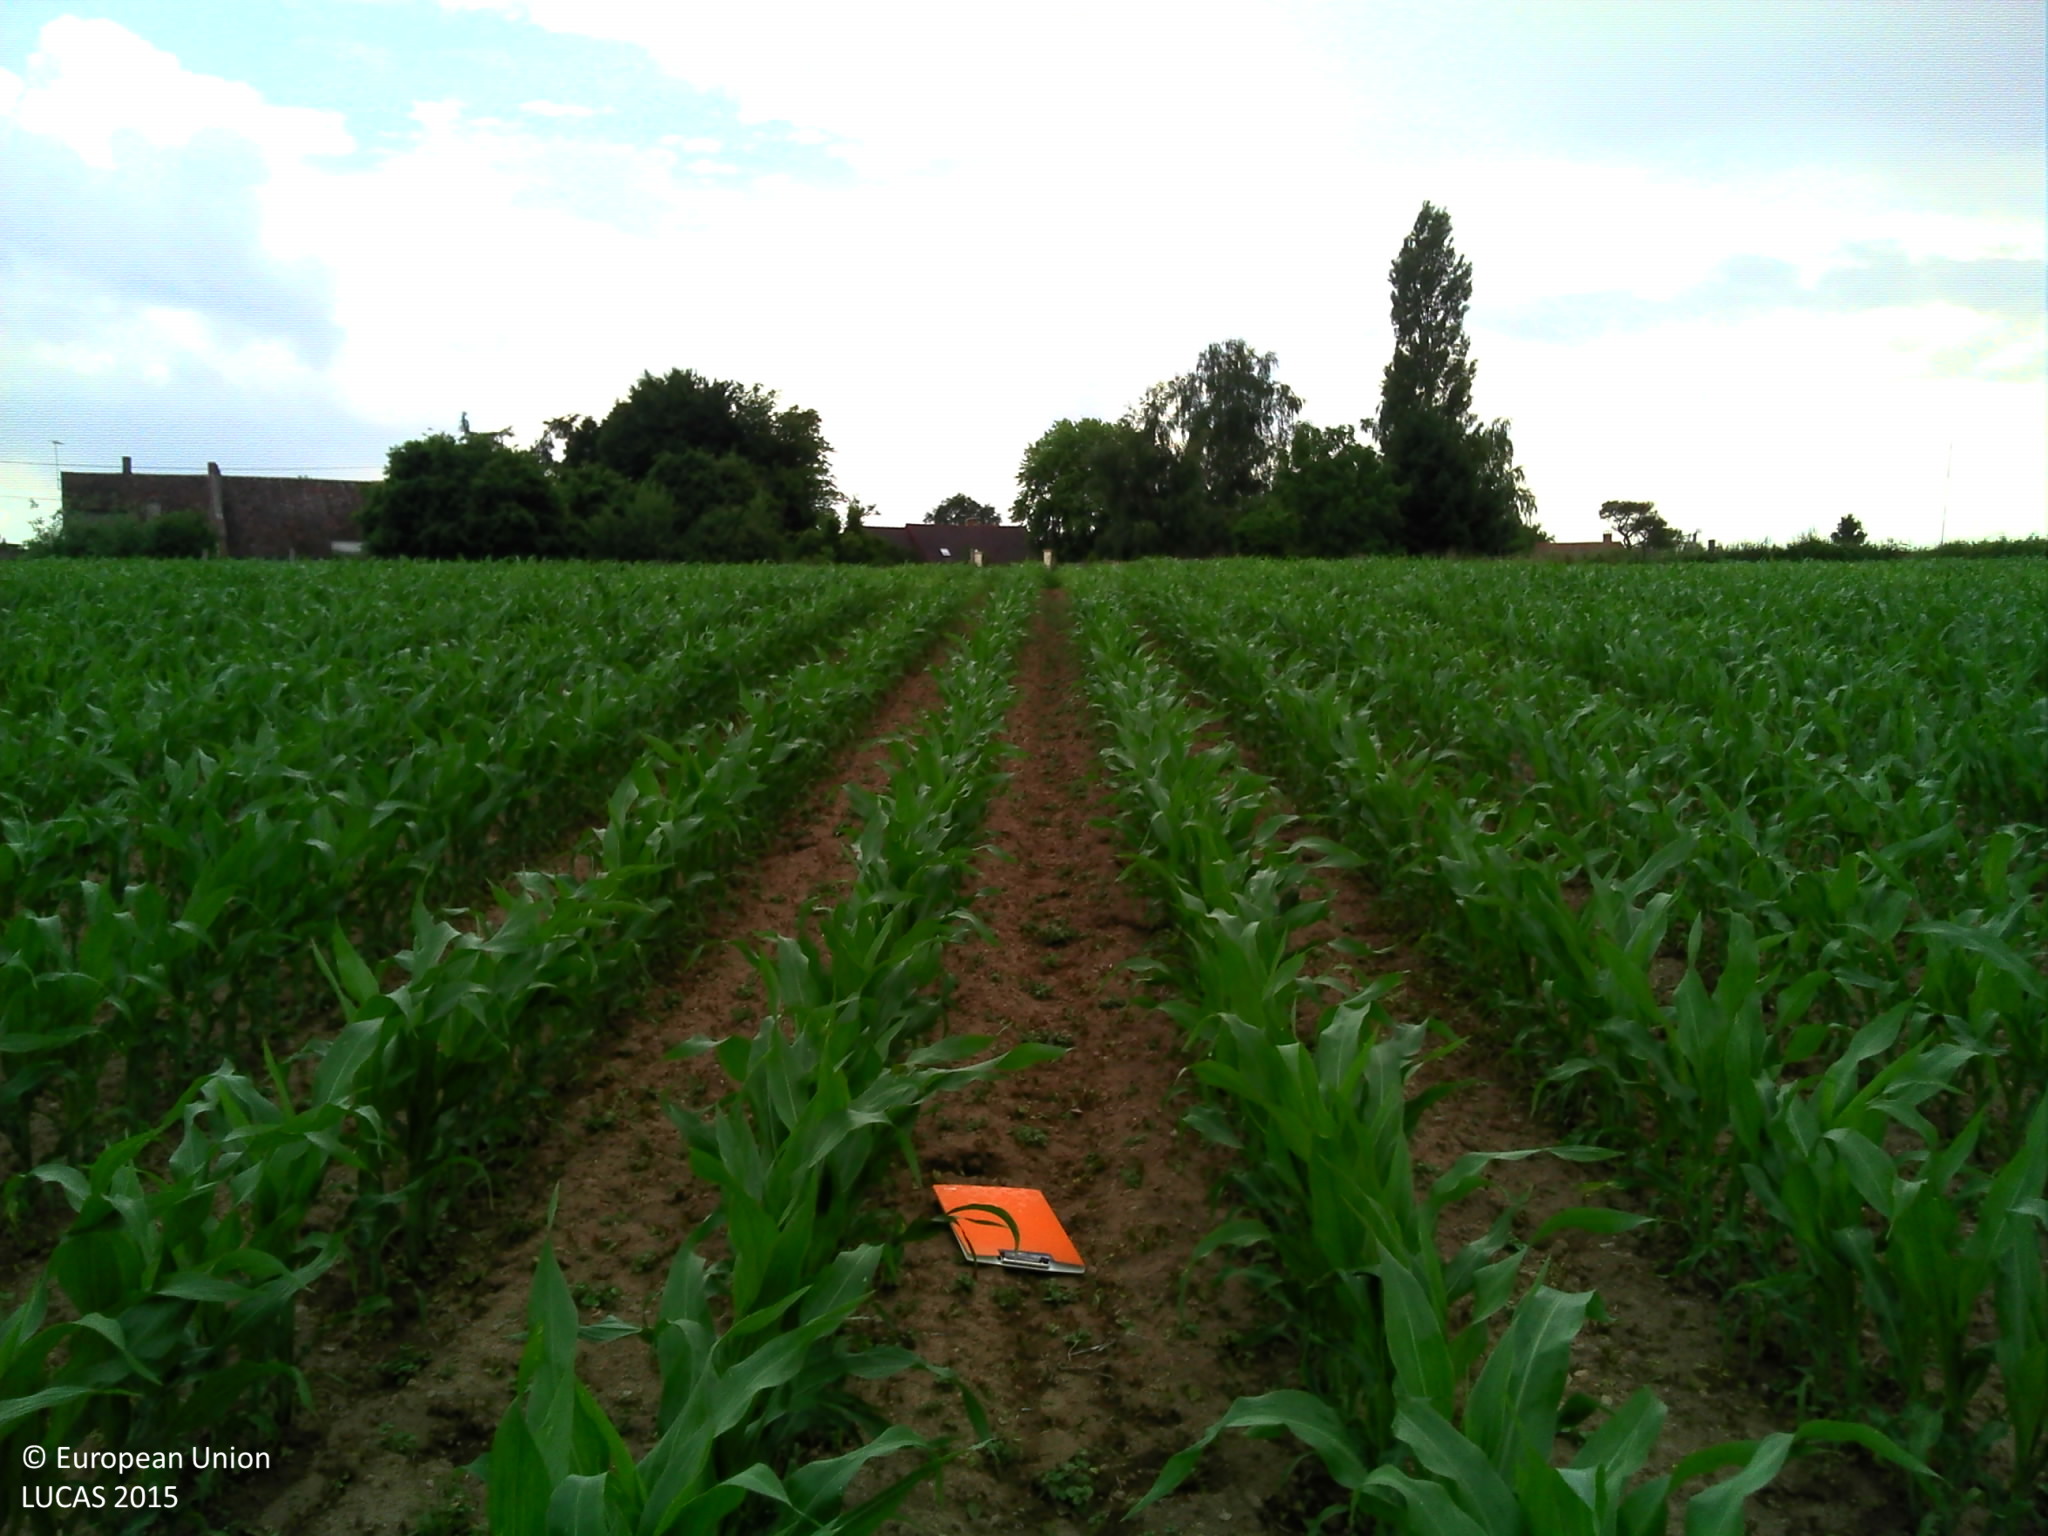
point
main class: Cropland
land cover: Maize
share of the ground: 25 - 50 %
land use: Agriculture (excluding fallow land and kitchen gardens)
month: June
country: FR
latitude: 46.3238
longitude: 3.0491
